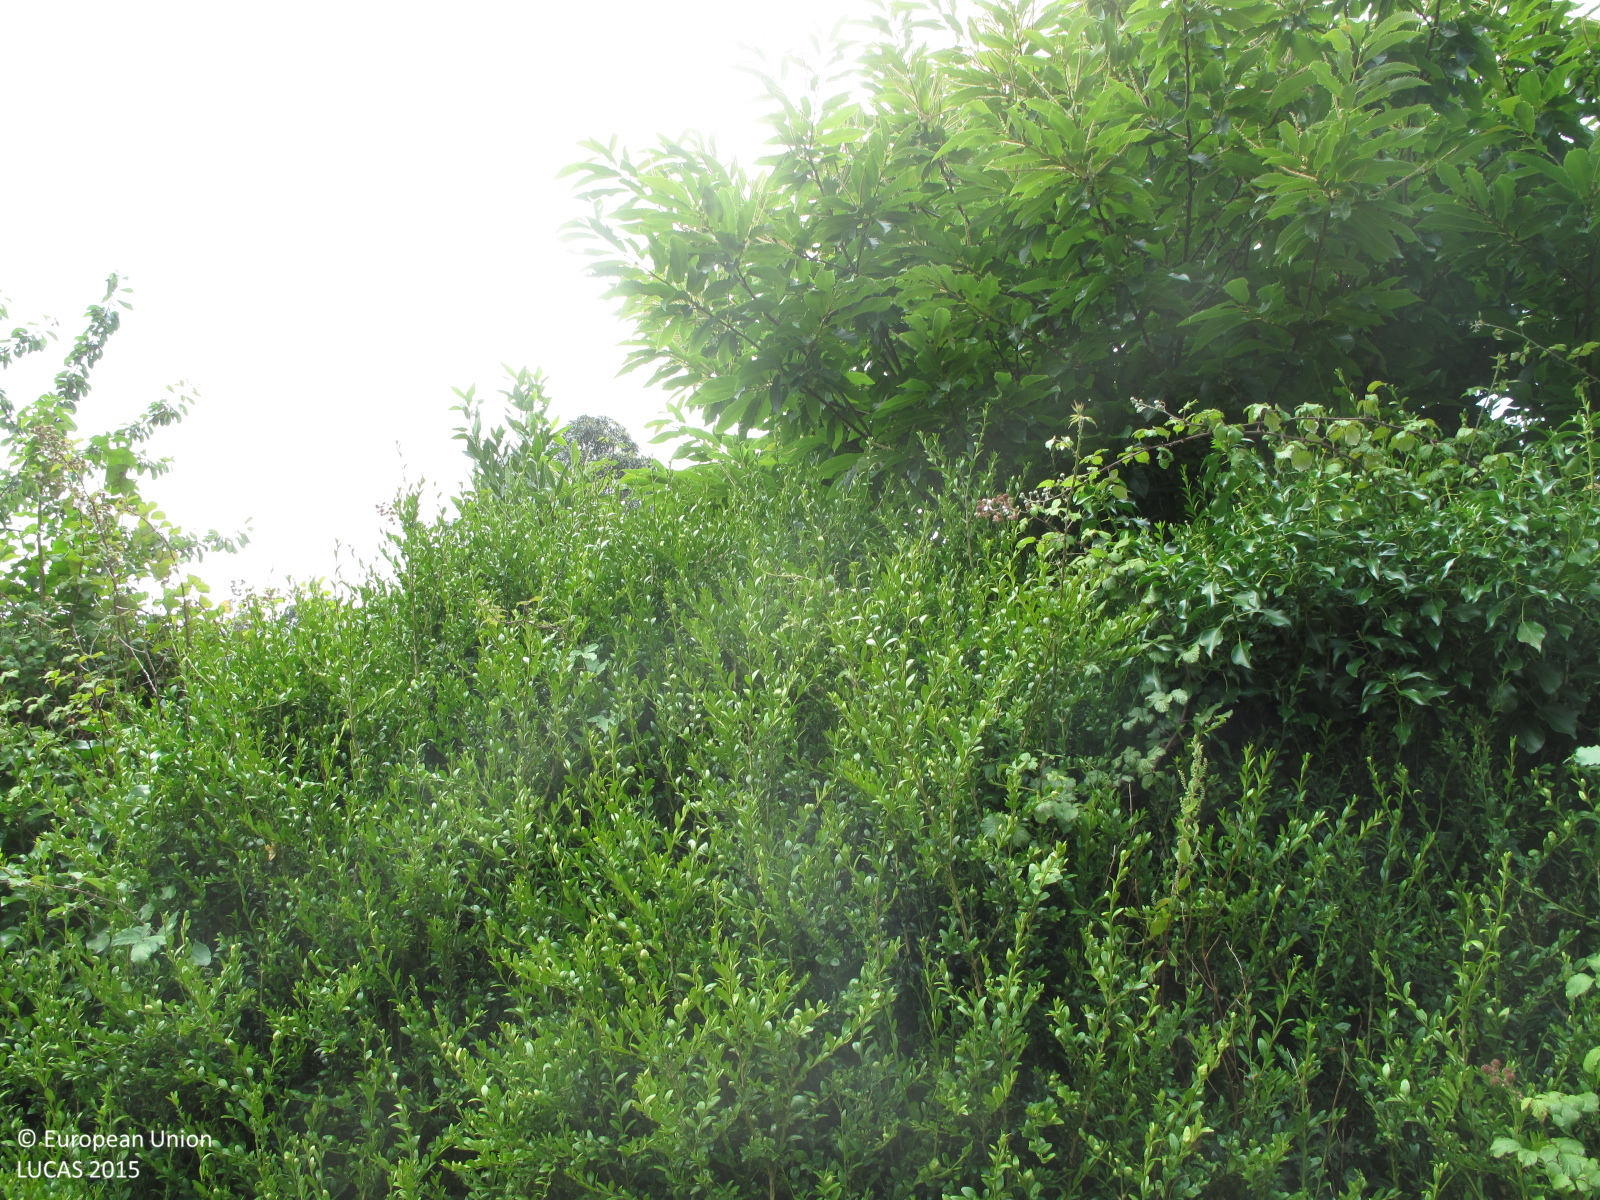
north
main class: Grassland
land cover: Grassland with sparse tree/shrub cover
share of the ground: > 75 %
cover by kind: herbaceous plants 95 %, broadleaved forest trees 5 %
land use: Residential
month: July
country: ES
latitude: 43.6395
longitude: -8.0360
